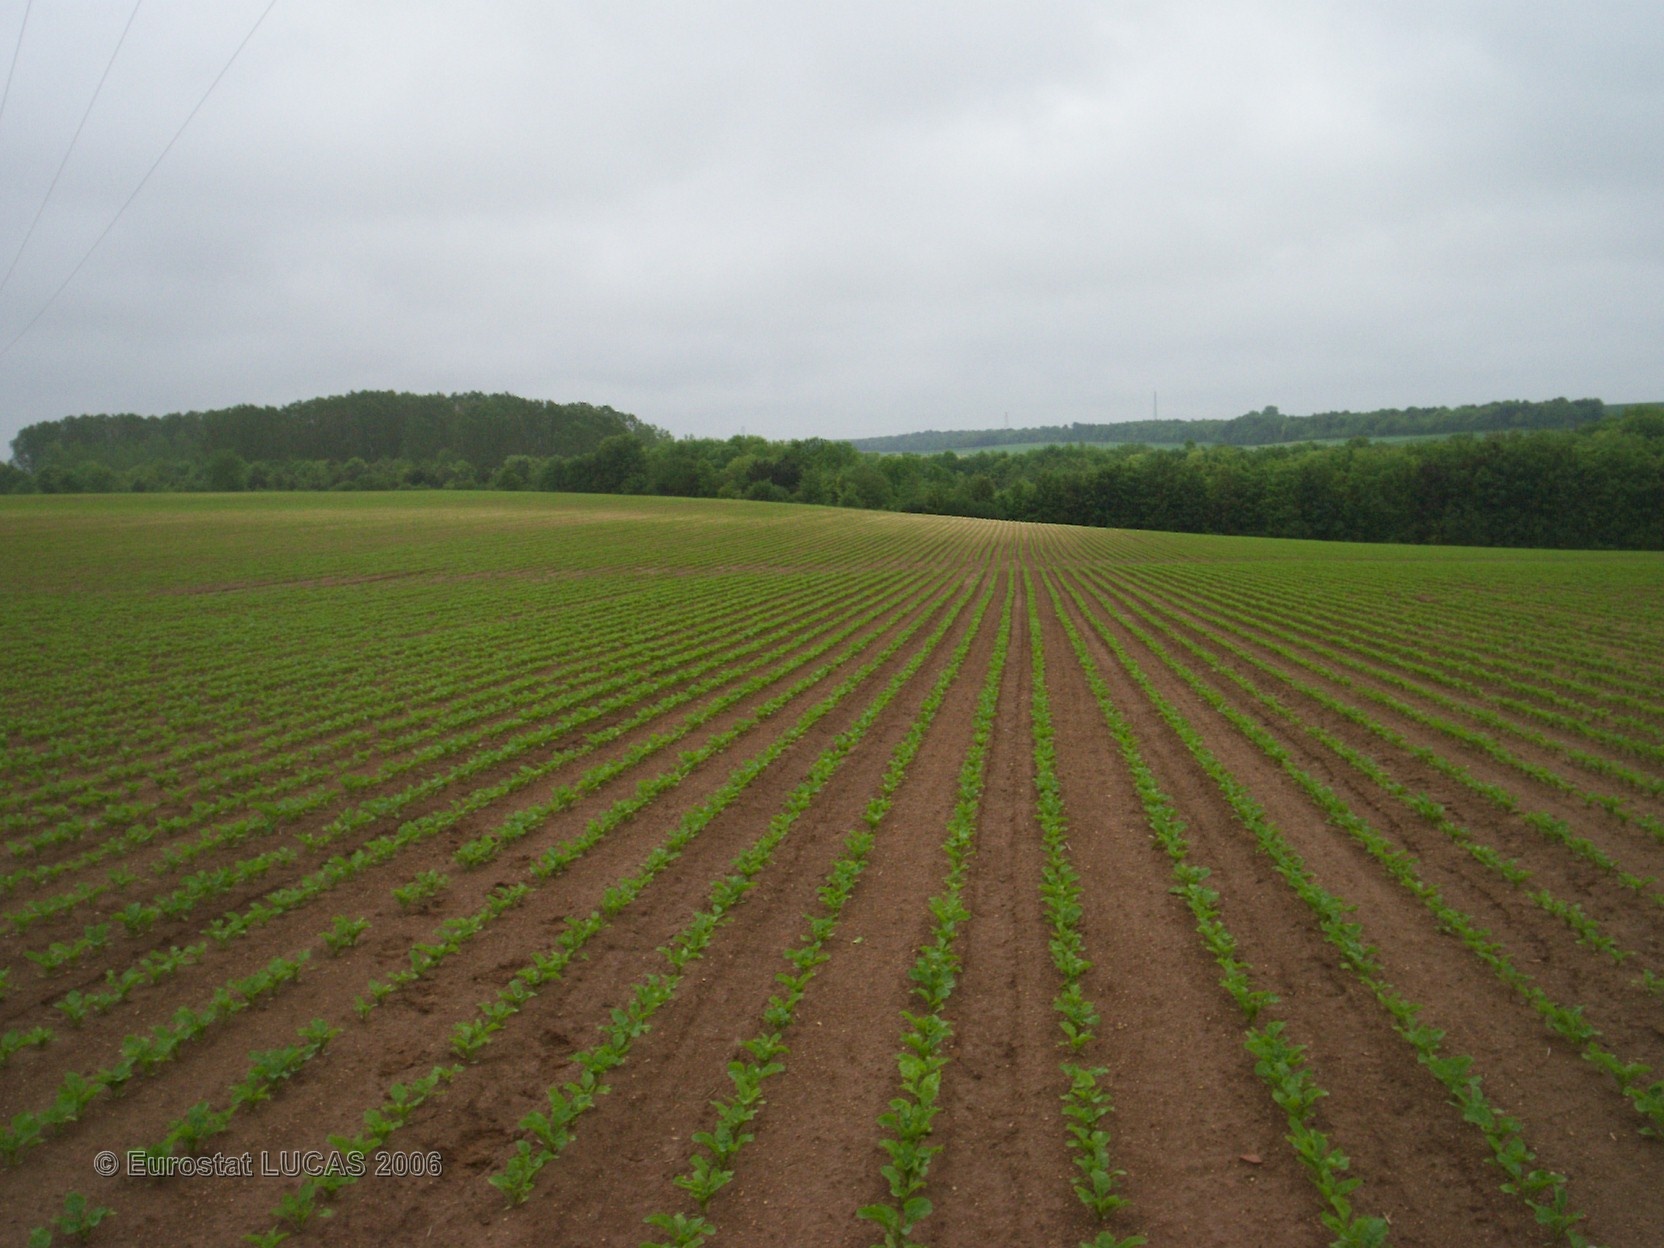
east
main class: Cropland
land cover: Sugar beet
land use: Agriculture (excluding fallow land and kitchen gardens)
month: May
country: FR
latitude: 49.4150
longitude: 4.3859
